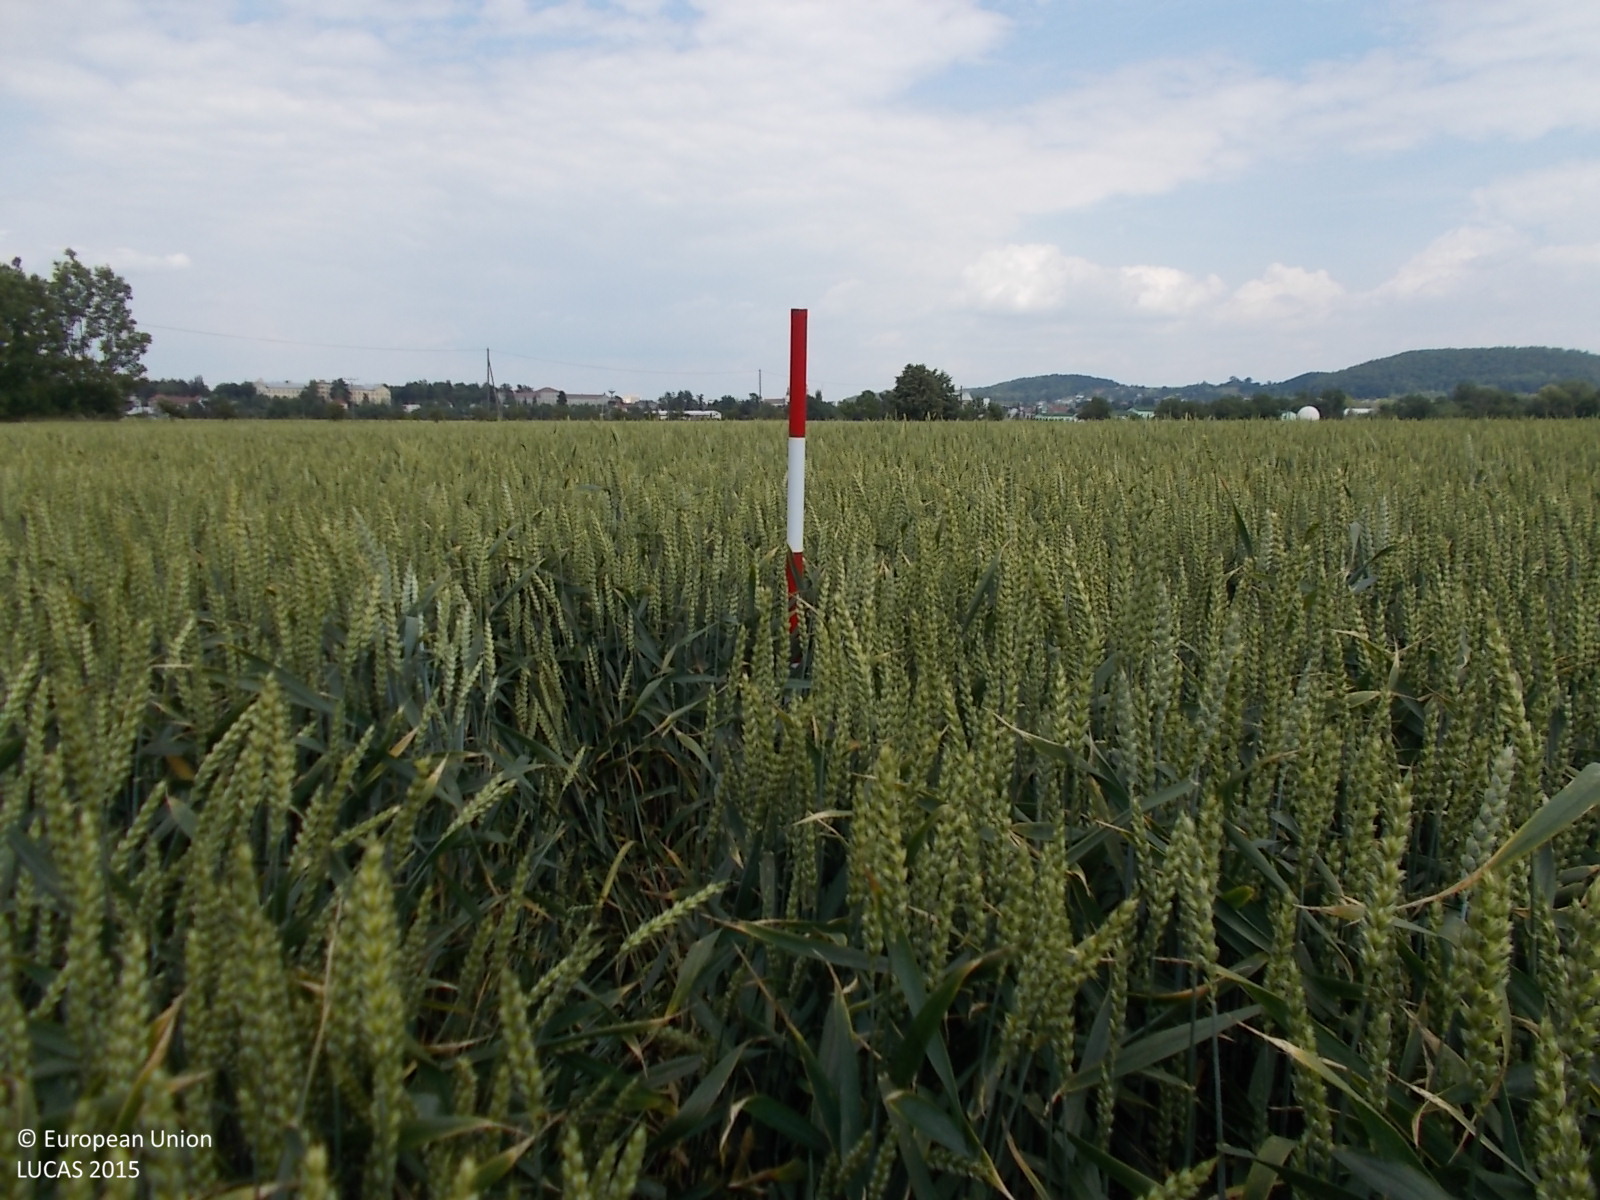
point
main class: Cropland
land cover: Common wheat
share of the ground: > 75 %
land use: Agriculture (excluding fallow land and kitchen gardens)
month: June
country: CZ
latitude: 49.5435
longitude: 17.7112
